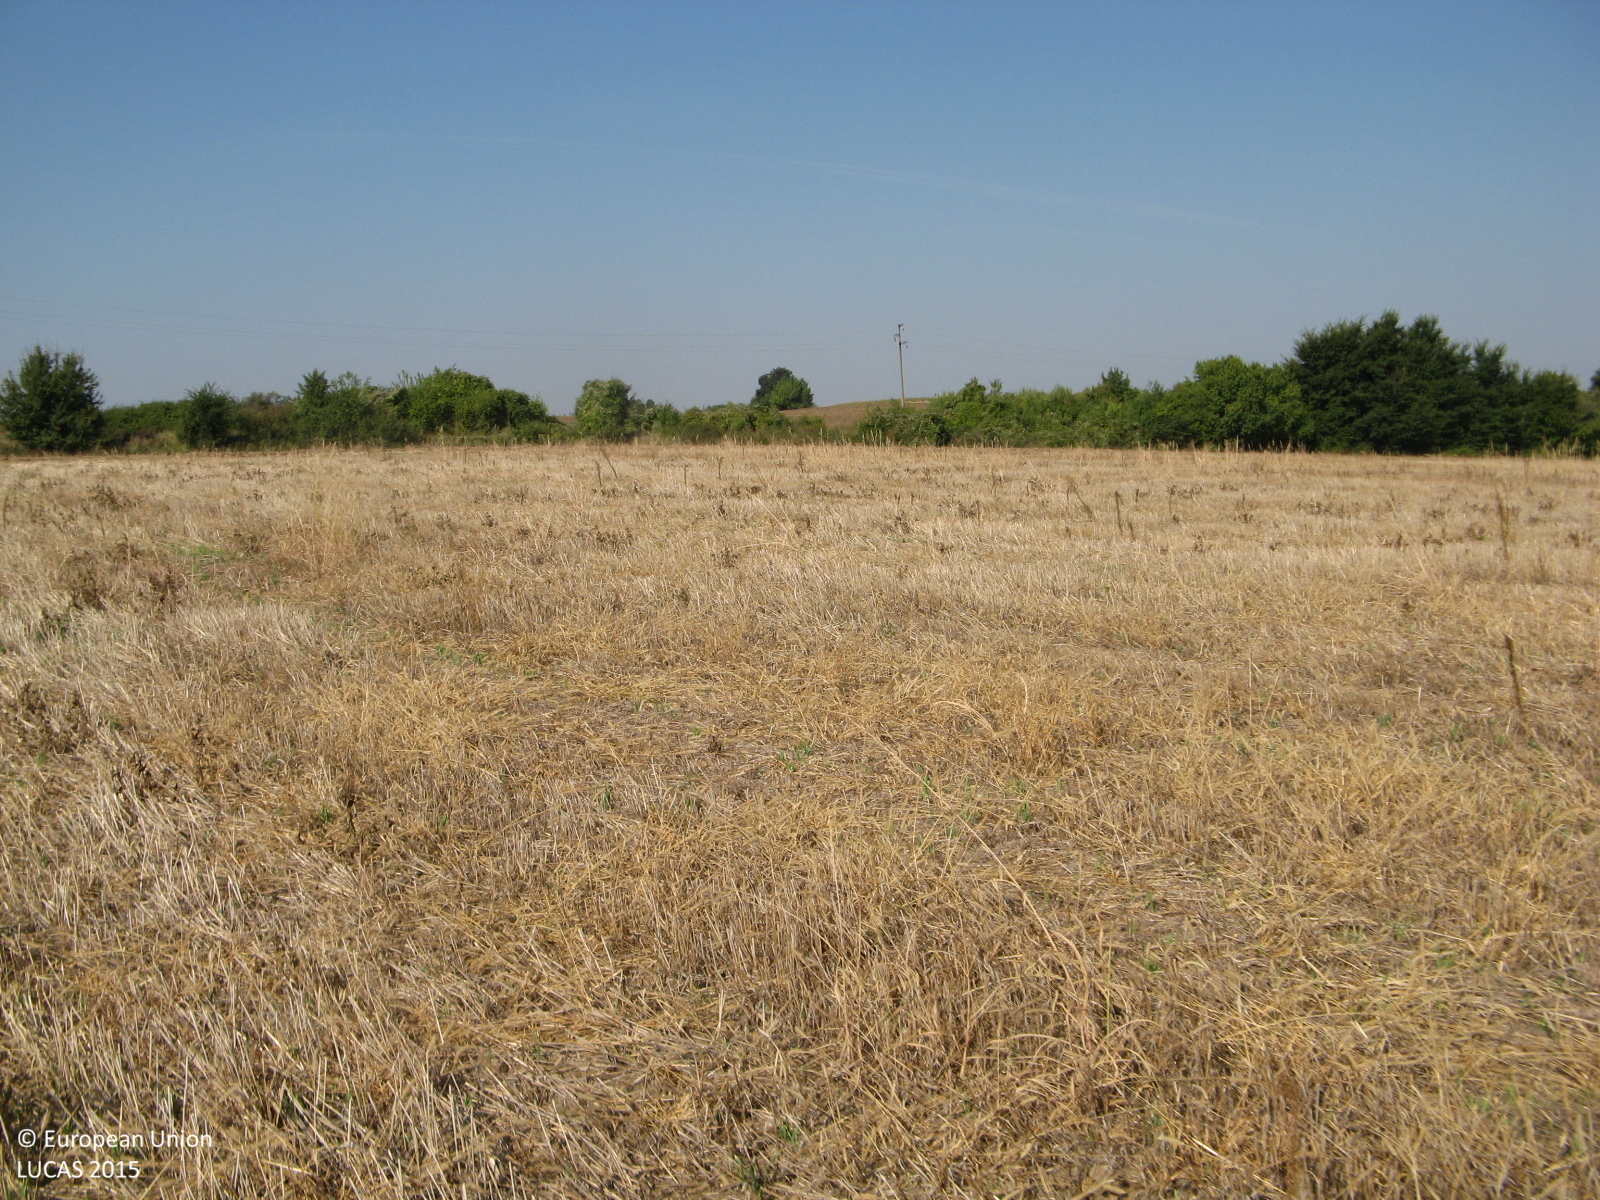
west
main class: Cropland
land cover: Barley
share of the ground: 50 - 75 %
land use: Agriculture (excluding fallow land and kitchen gardens)
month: August
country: BG
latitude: 43.5007
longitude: 25.7823
